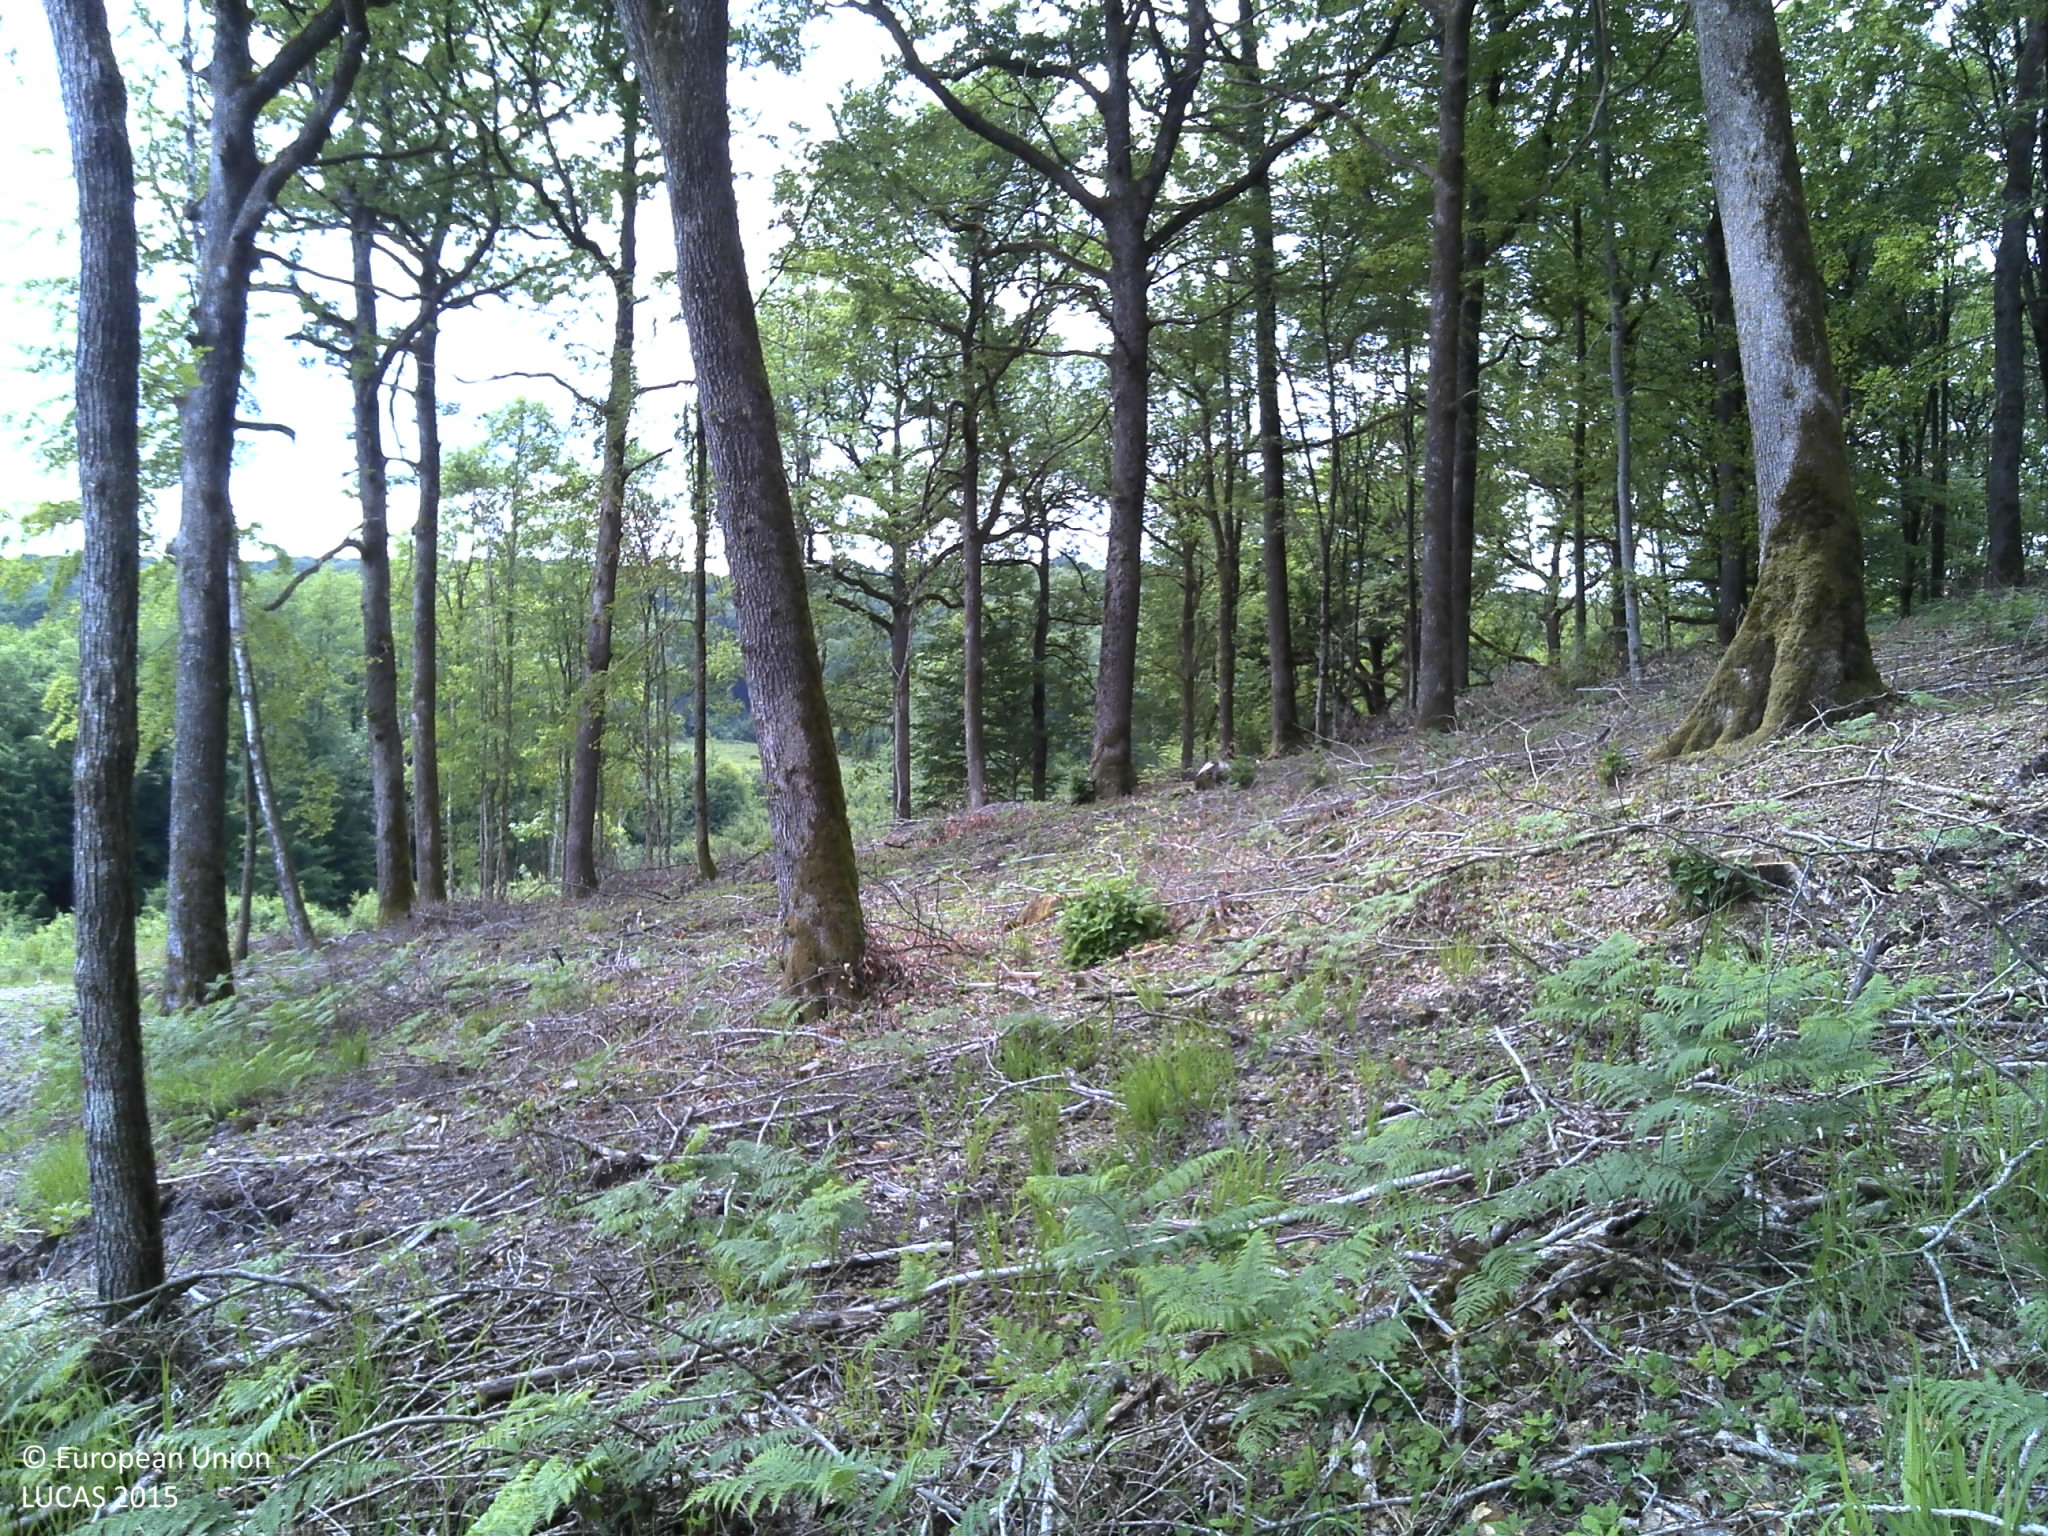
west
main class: Woodland
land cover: Broadleaved woodland
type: acidophilous oak and oak-birch forest
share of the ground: > 75 %
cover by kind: broadleaved forest trees 55 %, herbaceous plants 40 %, lichens and mosses 5 %
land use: Forestry
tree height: < 5 m
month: June
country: FR
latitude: 49.3835
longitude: 4.8591
